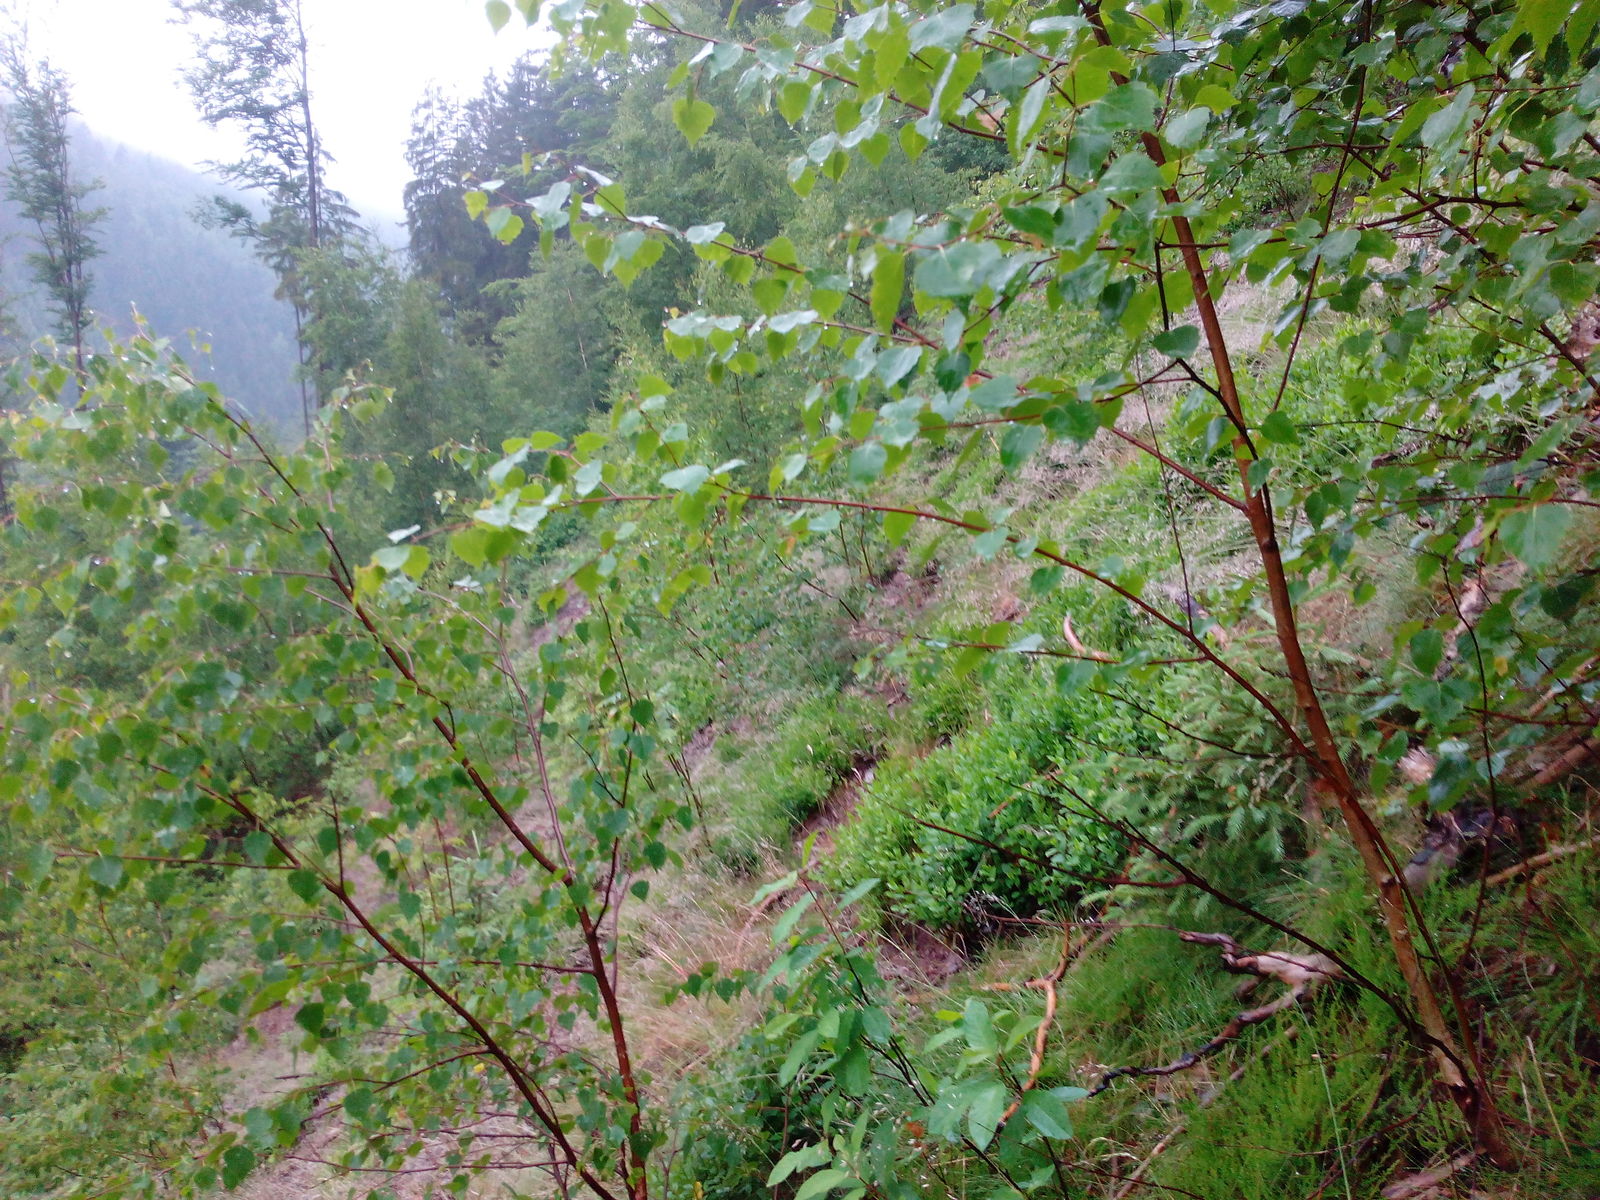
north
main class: Woodland
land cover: Broadleaved woodland
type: mesophytic deciduous forest
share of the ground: 50 - 75 %
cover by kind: broadleaved forest trees 65 %, herbaceous plants 20 %, shrubs 15 %
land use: Forestry
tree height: < 5 m
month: June
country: DE
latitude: 50.4314
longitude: 11.0274
